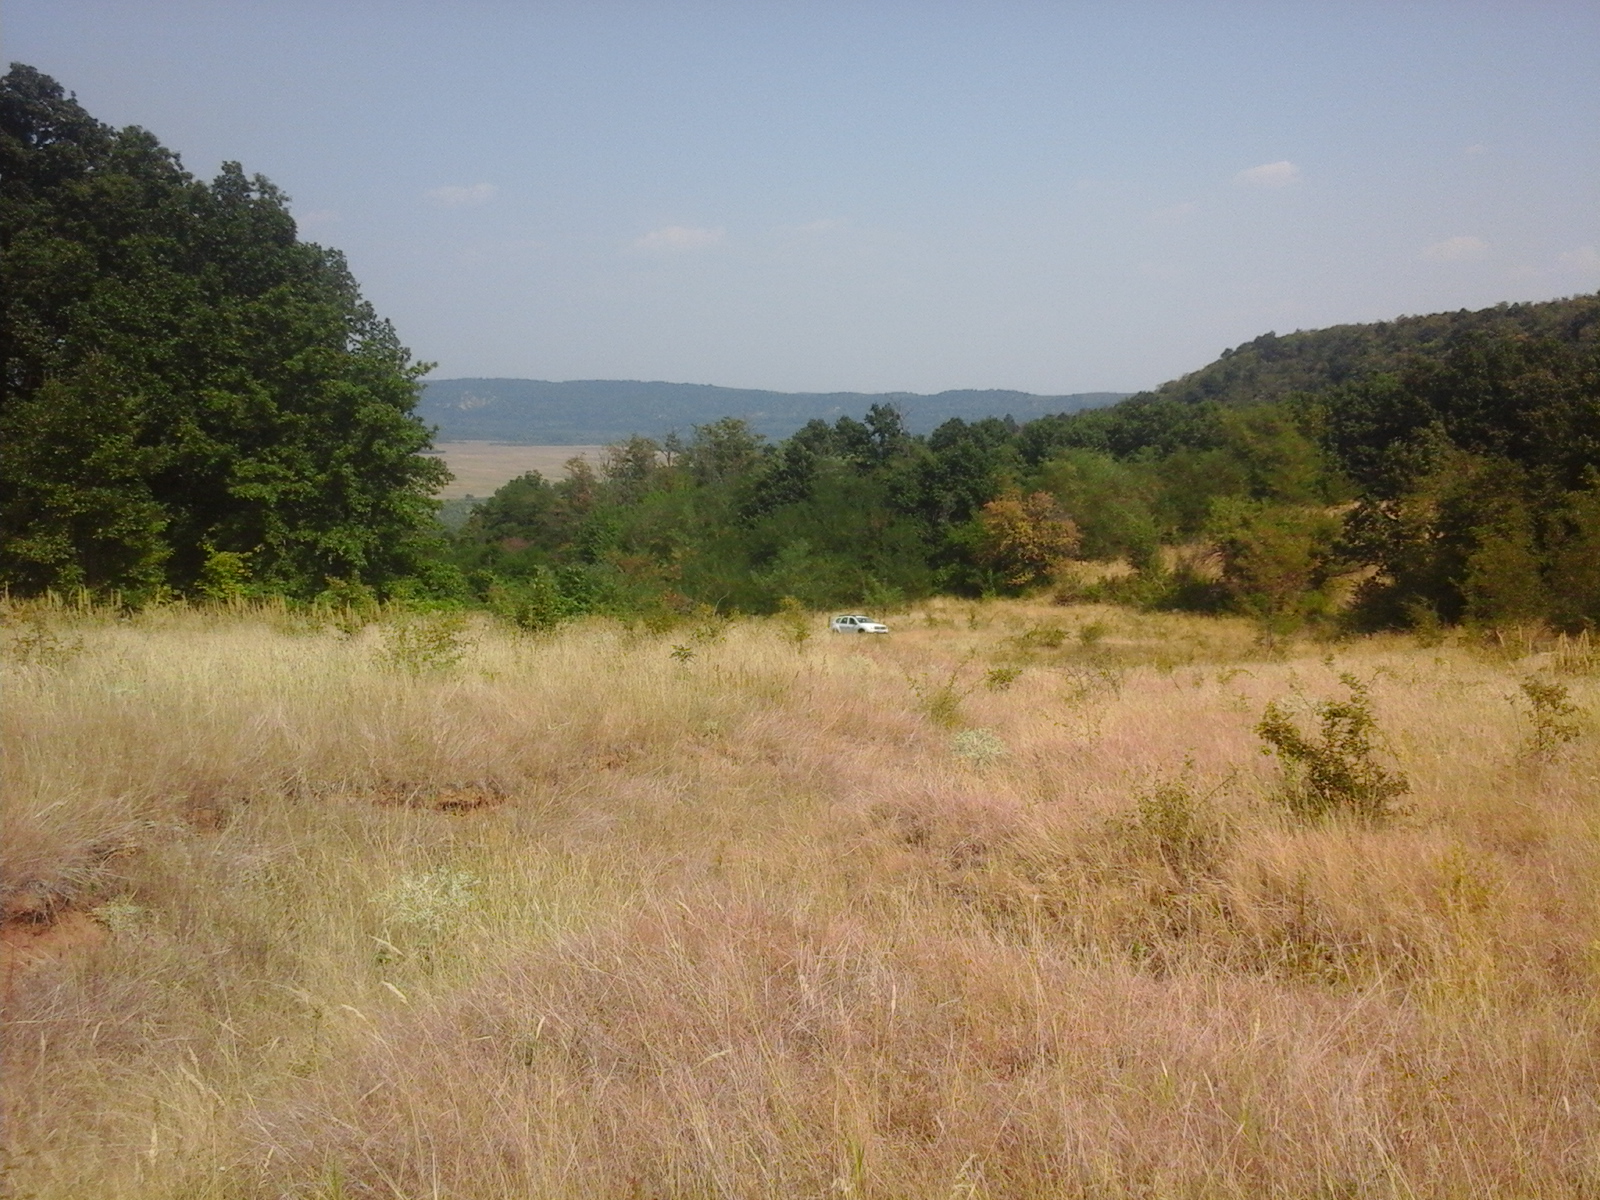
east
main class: Grassland
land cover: Grassland with sparse tree/shrub cover
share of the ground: > 75 %
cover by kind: herbaceous plants 85 %, shrubs 10 %, broadleaved forest trees 5 %
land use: Agriculture (excluding fallow land and kitchen gardens)
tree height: < 5 m
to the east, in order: Grassland with sparse tree/shrub cover; Tracks; Grassland without tree/shrub cover; Broadleaved woodland; Grassland with sparse tree/shrub cover; Broadleaved woodland
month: August
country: RO
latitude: 44.4962
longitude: 22.7053
